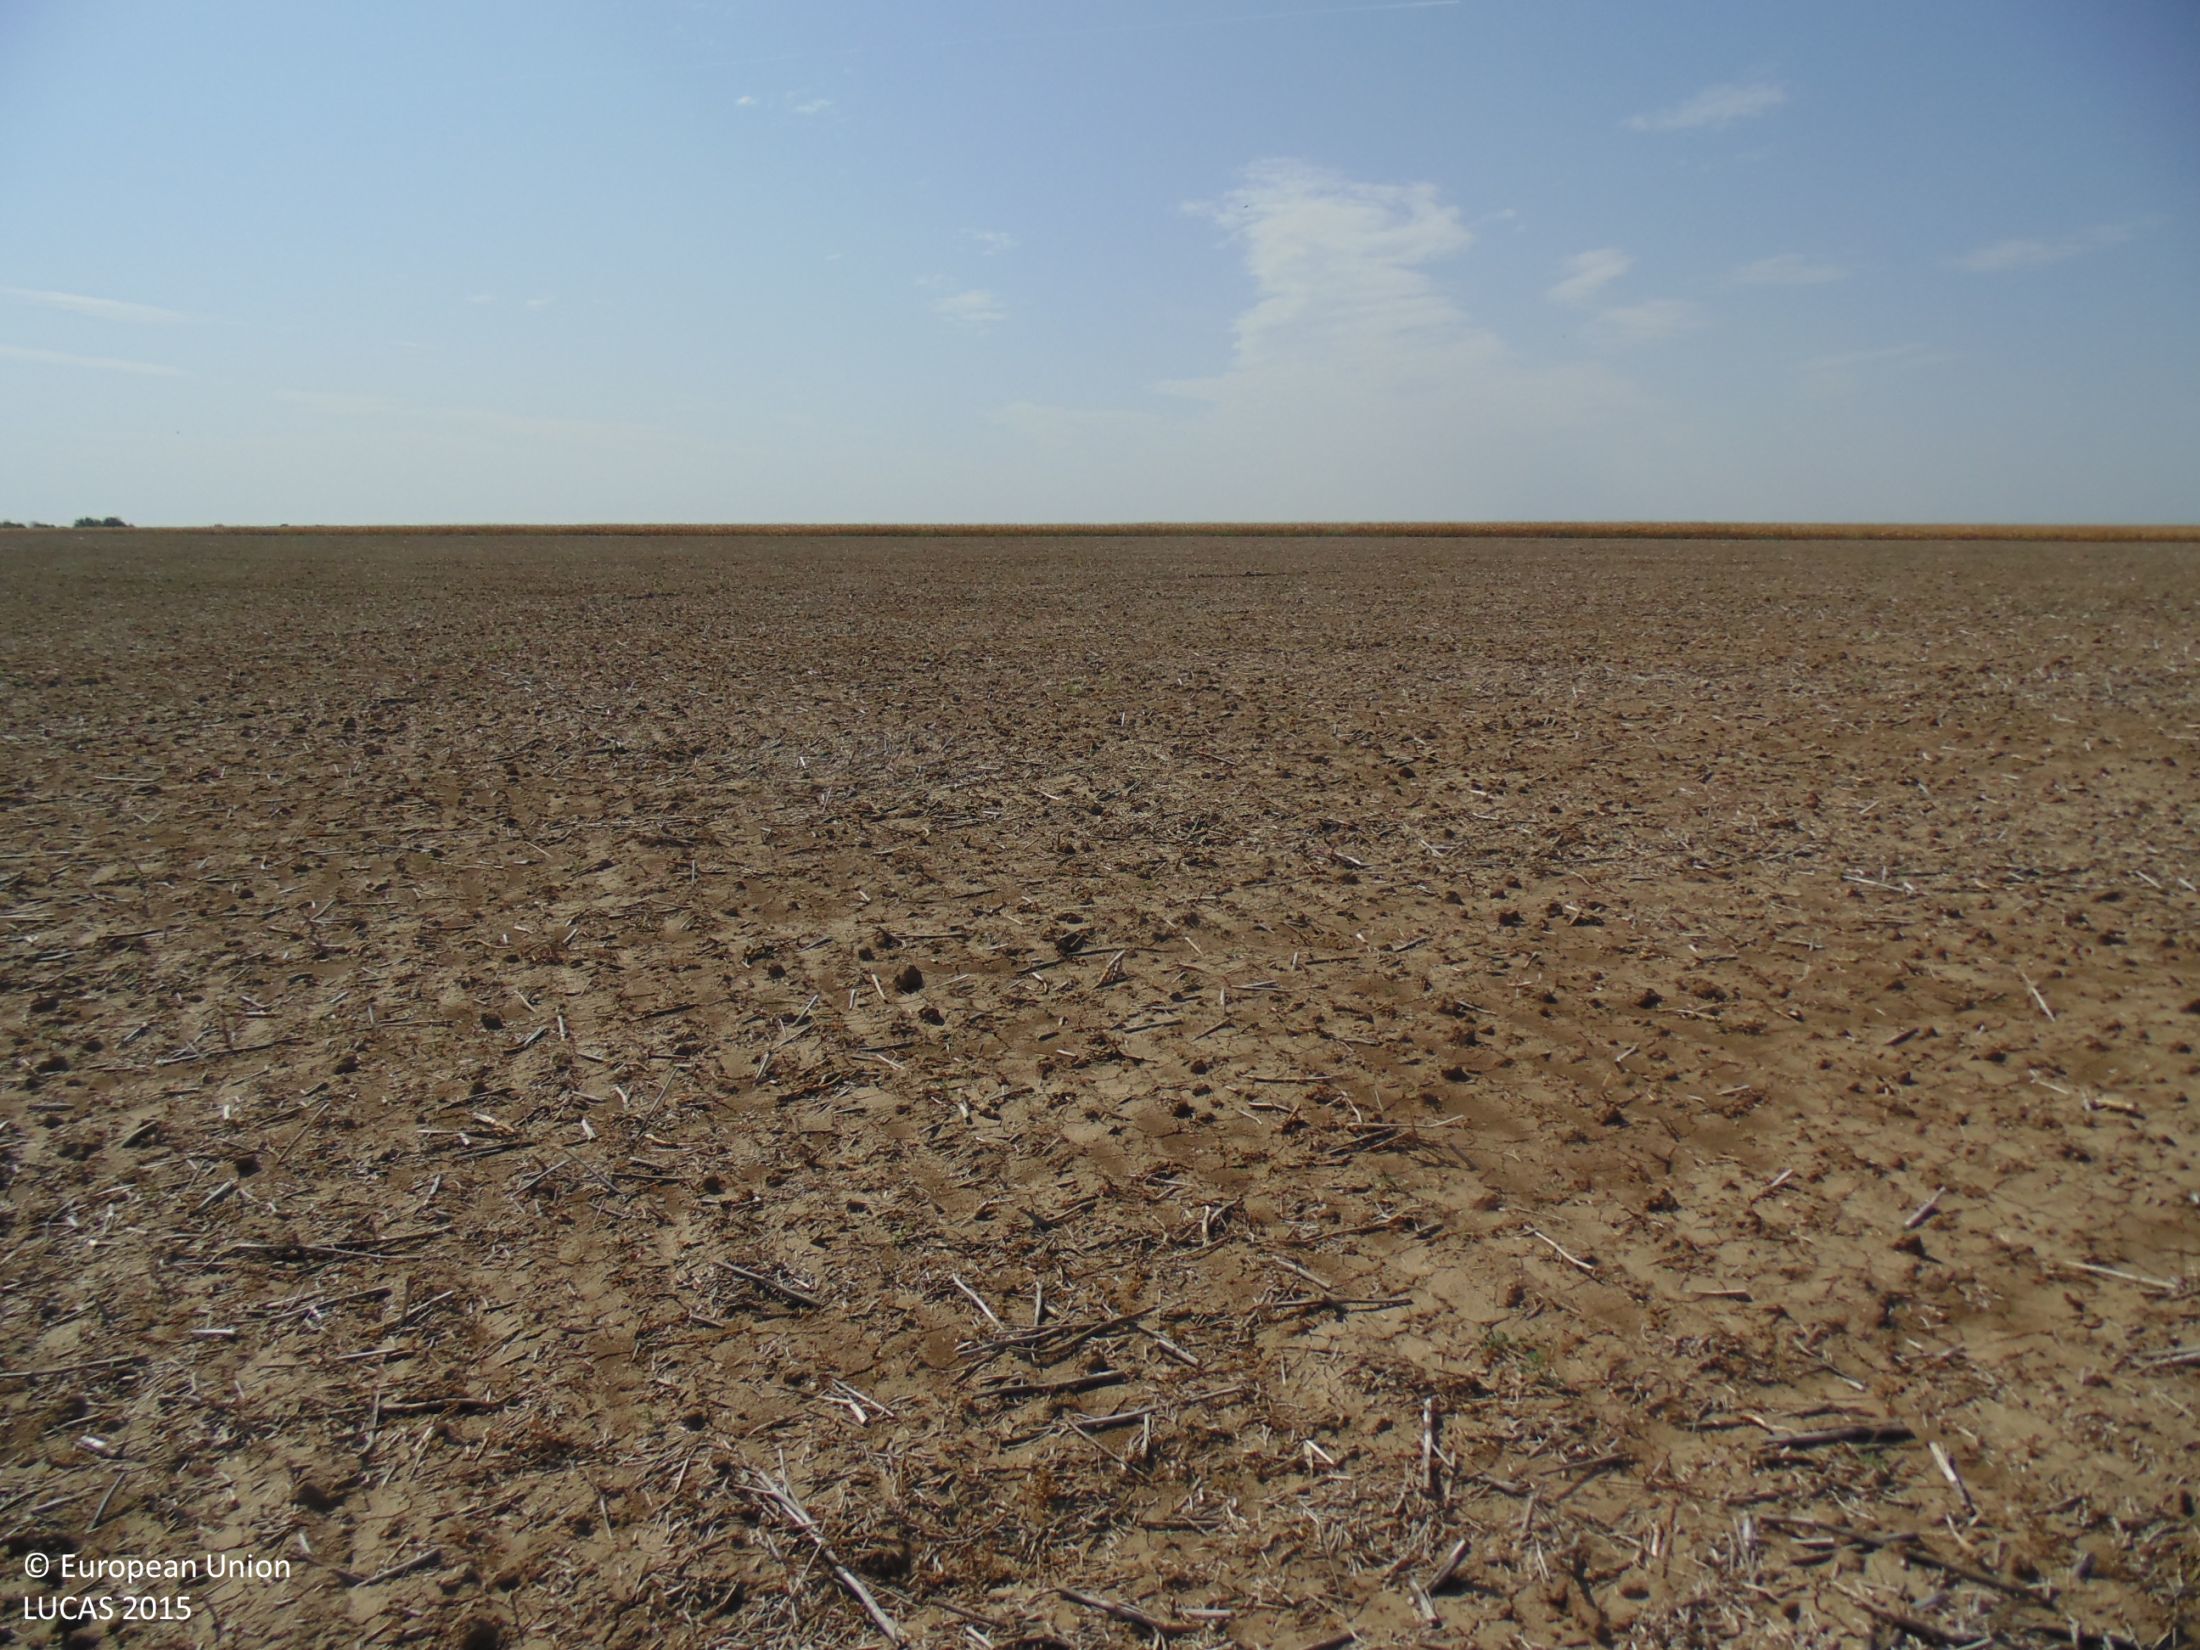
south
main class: Cropland
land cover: Rape and turnip rape
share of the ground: < 10 %
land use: Agriculture (excluding fallow land and kitchen gardens)
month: September
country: BG
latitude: 44.0793
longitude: 27.2001
